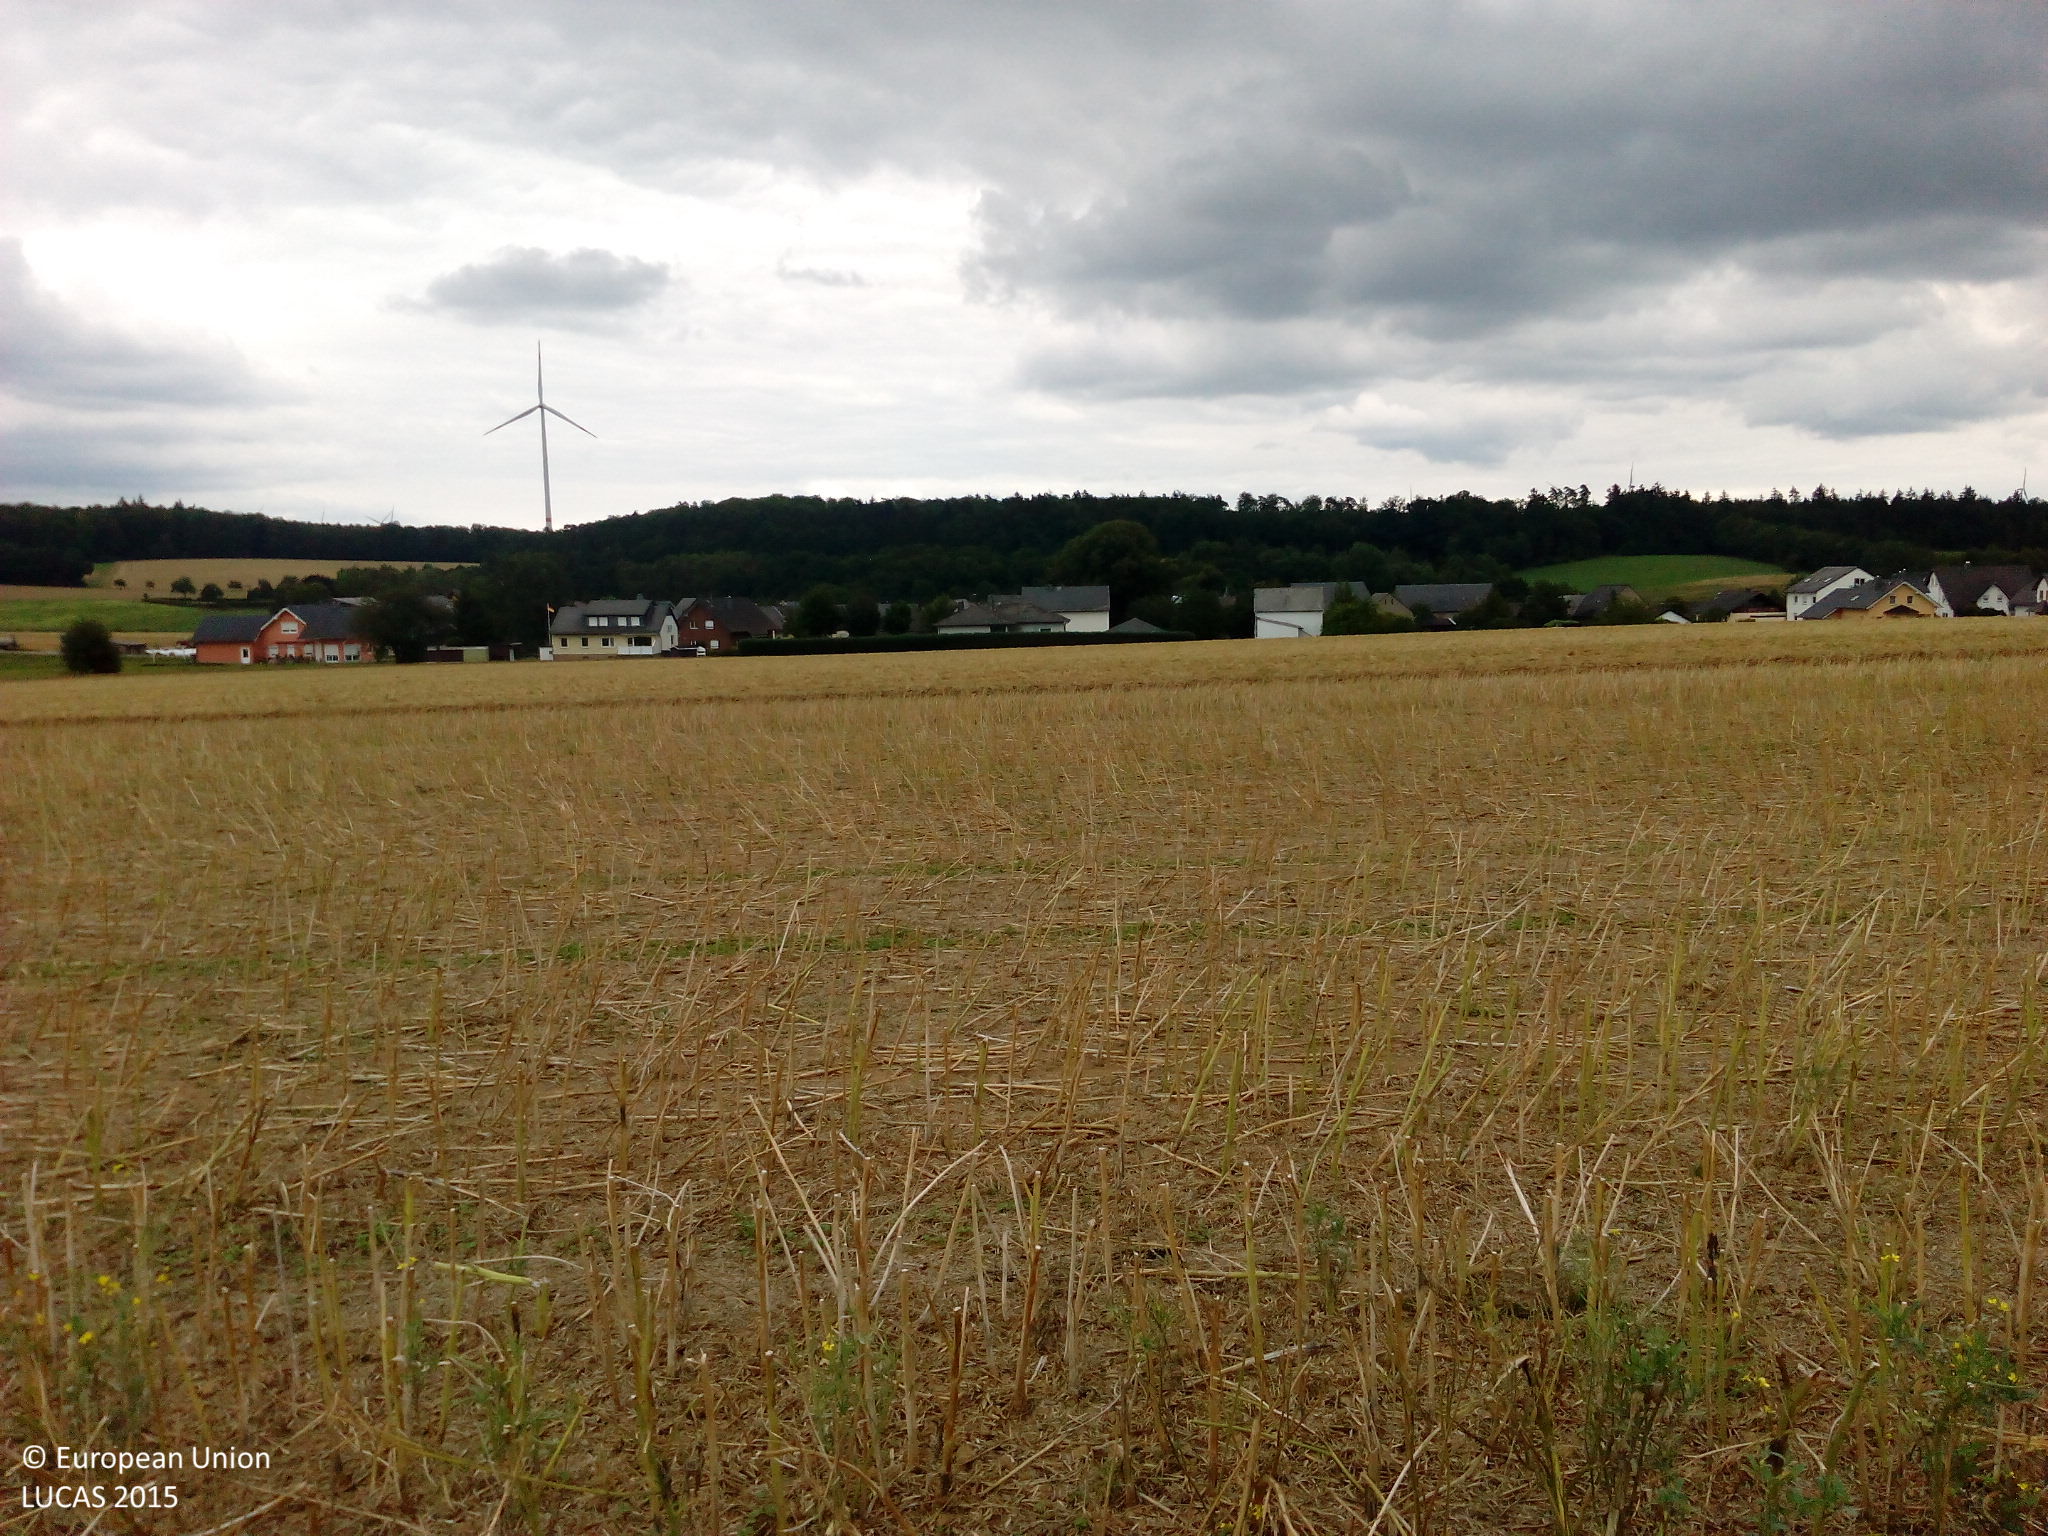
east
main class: Cropland
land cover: Rape and turnip rape
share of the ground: < 10 %
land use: Agriculture (excluding fallow land and kitchen gardens)
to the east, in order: Rape and turnip rape; Barley; Artificial constructions in urban areas
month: August
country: DE
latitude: 50.0136
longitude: 7.5303
